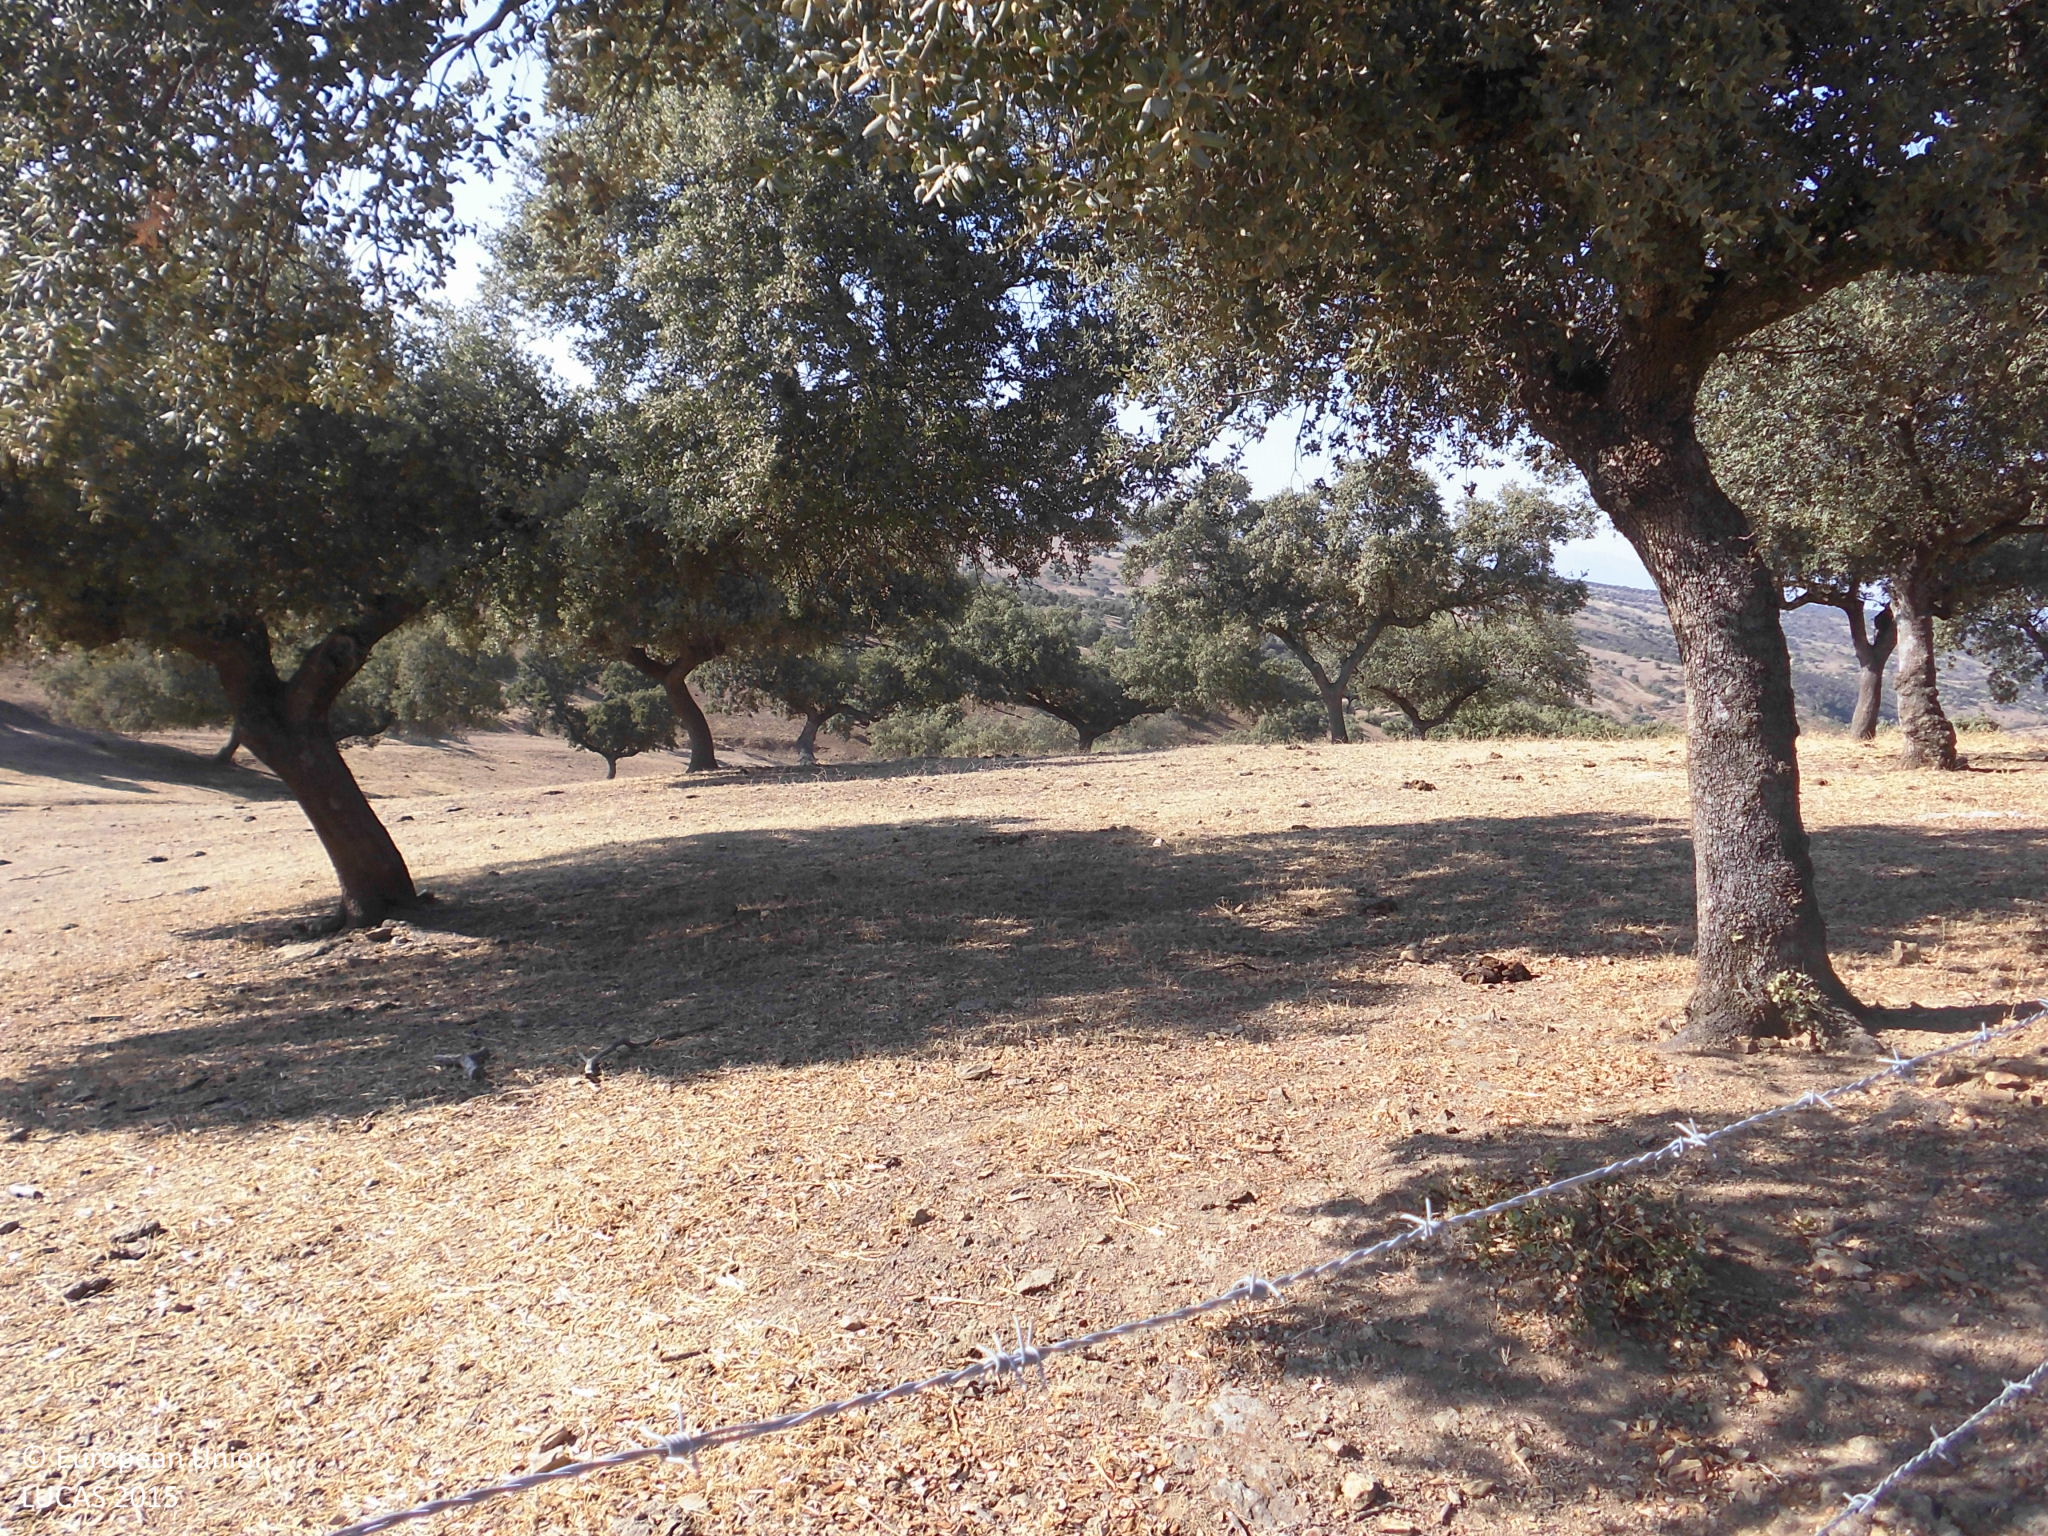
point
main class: Woodland
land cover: Broadleaved woodland
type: broadleaved evergreen forest
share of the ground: 10 - 25 %
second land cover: Grassland without tree/shrub cover
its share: > 75 %
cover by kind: herbaceous plants 80 %, broadleaved forest trees 20 %
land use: Forestry
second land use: Agriculture (excluding fallow land and kitchen gardens)
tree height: > 5 m
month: July
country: ES
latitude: 39.9461
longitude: -6.7147
